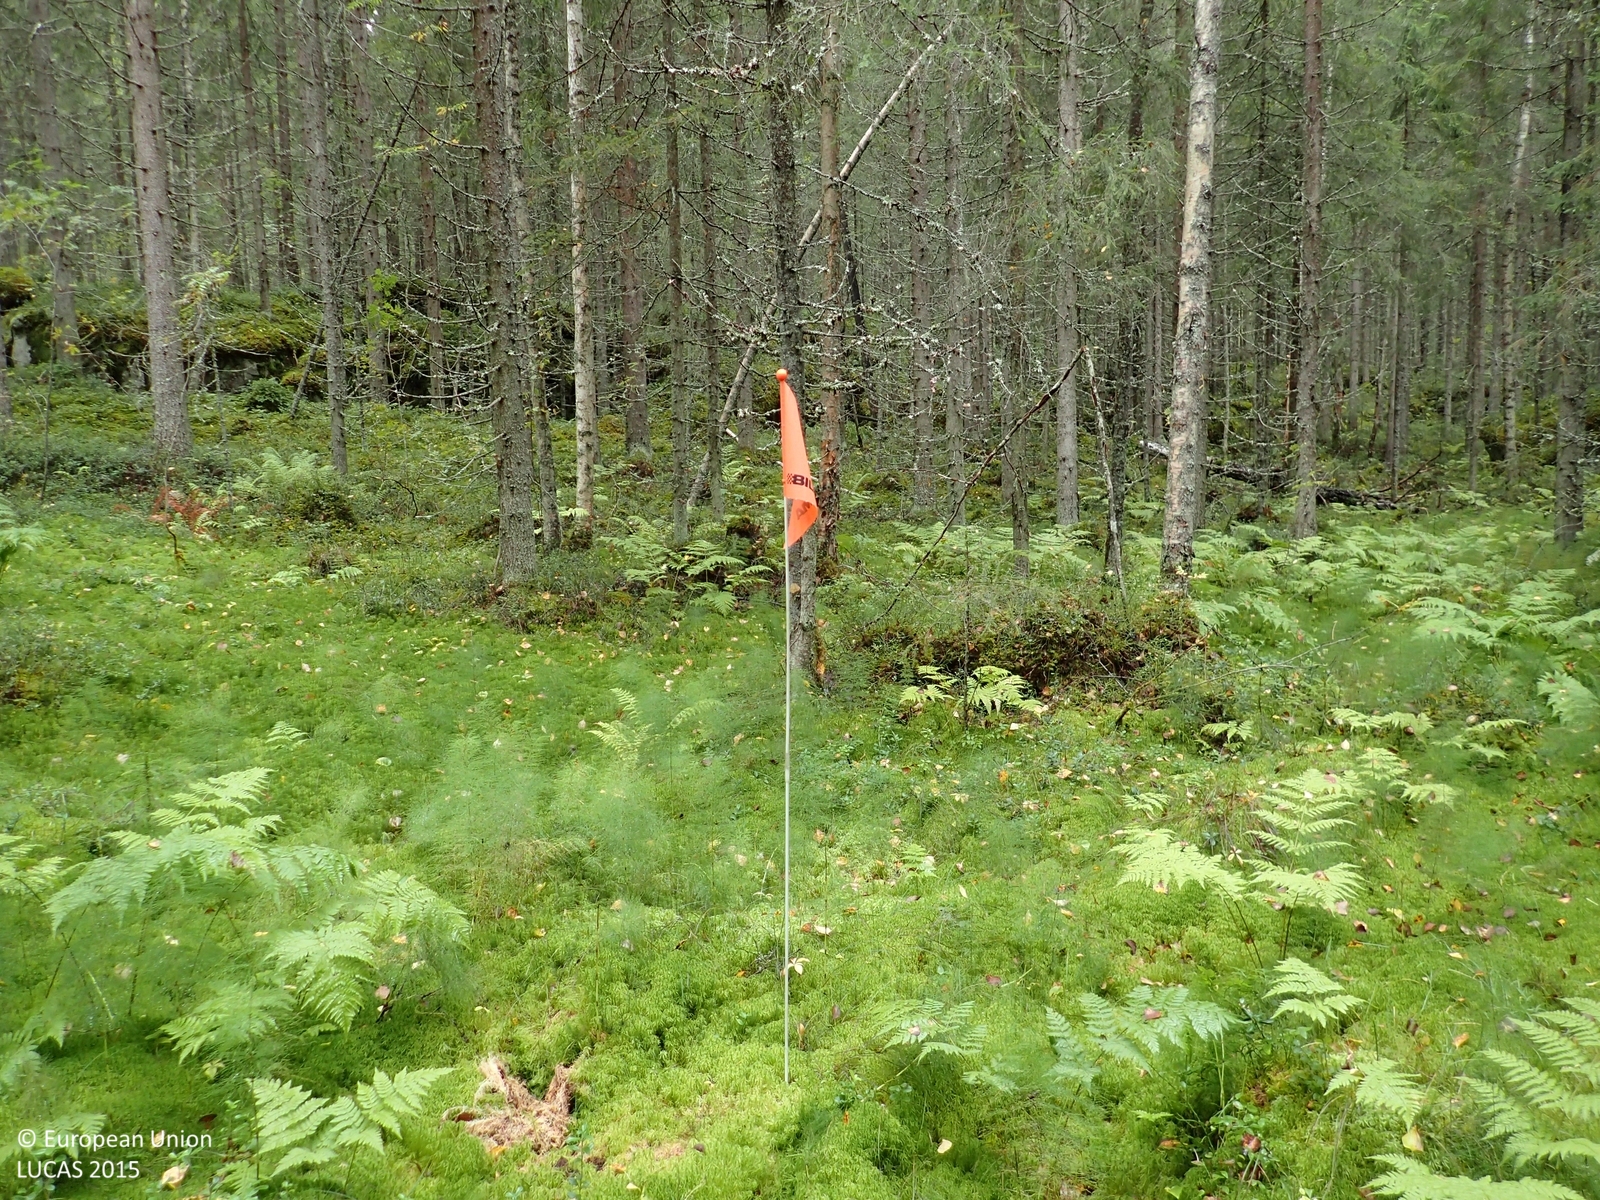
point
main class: Woodland
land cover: Spruce dominated coniferous woodland
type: mire and swamp forests
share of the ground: > 75 %
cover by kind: coniferous forest trees 65 %, broadleaved forest trees 10 %, shrubs 10 %, lichens and mosses 10 %, herbaceous plants 5 %
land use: Forestry
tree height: > 5 m
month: September
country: FI
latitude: 63.0988
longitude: 25.9858
